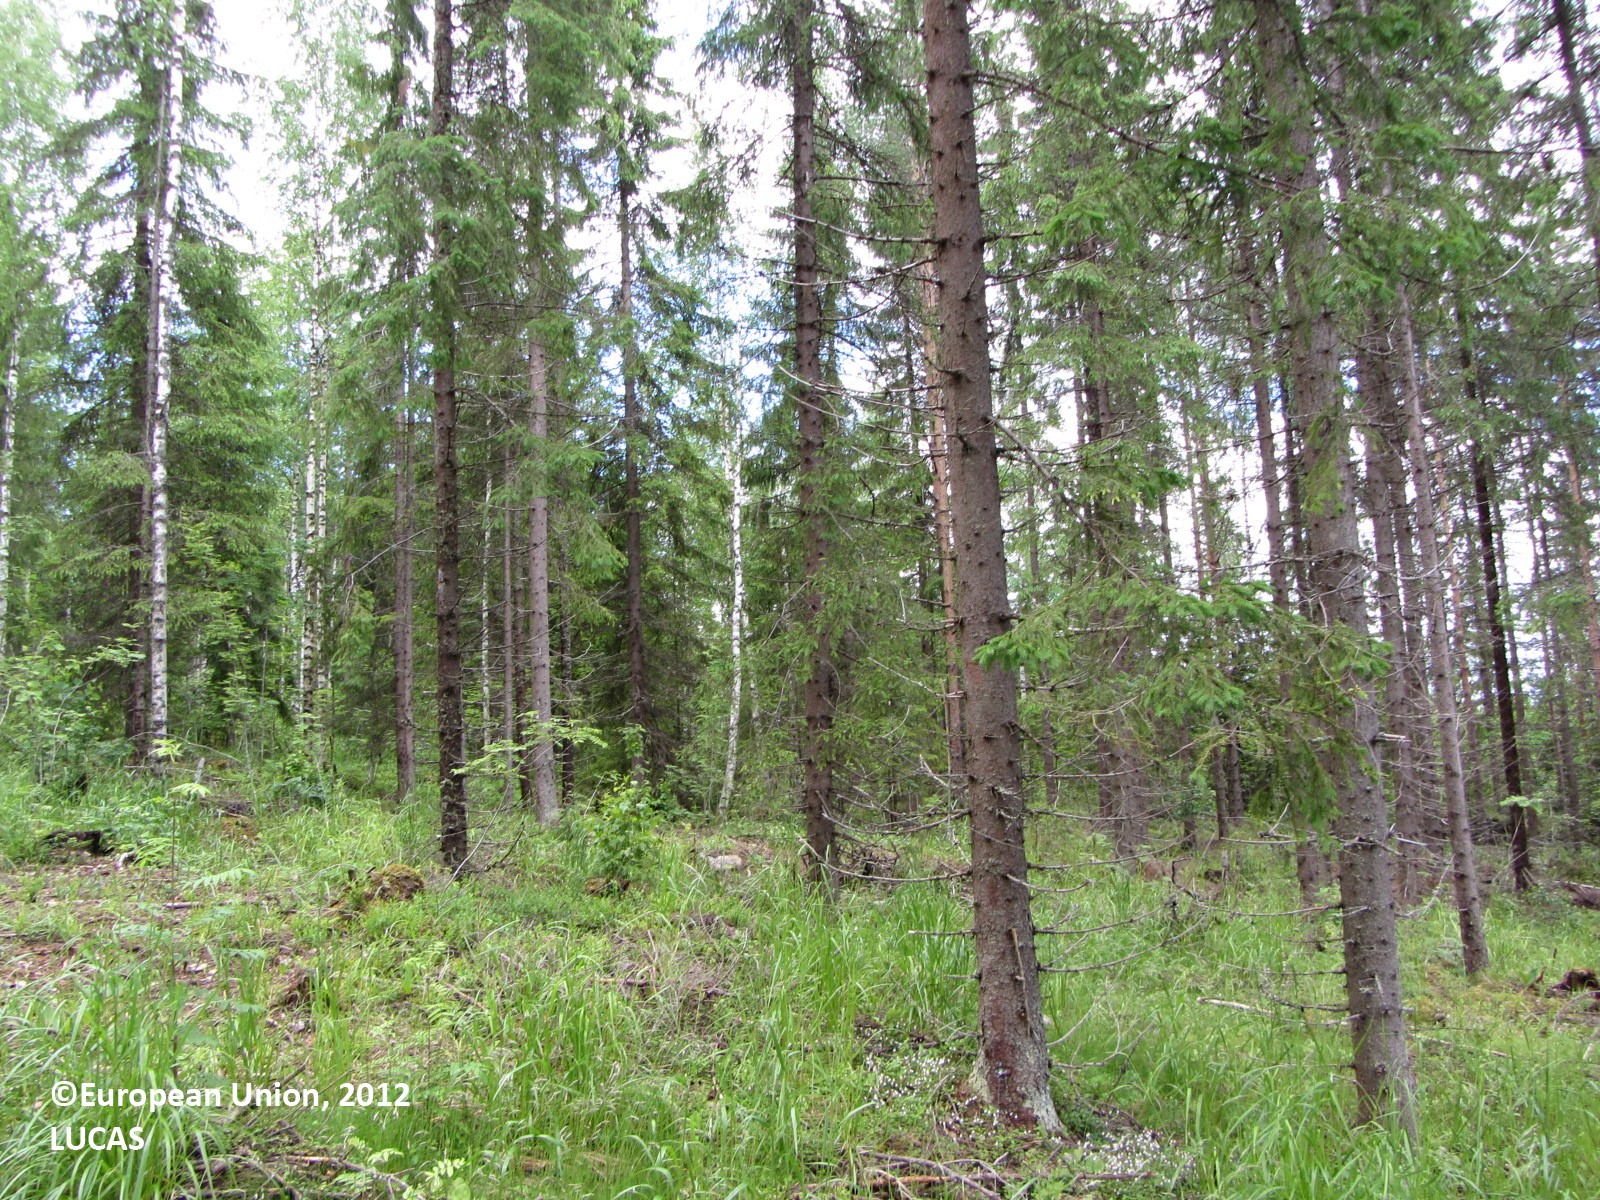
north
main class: Woodland
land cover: Other coniferous woodland
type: boreal forest
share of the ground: 50 - 75 %
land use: Forestry
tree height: > 5 m
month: June
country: FI
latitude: 61.9207
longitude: 25.2517
